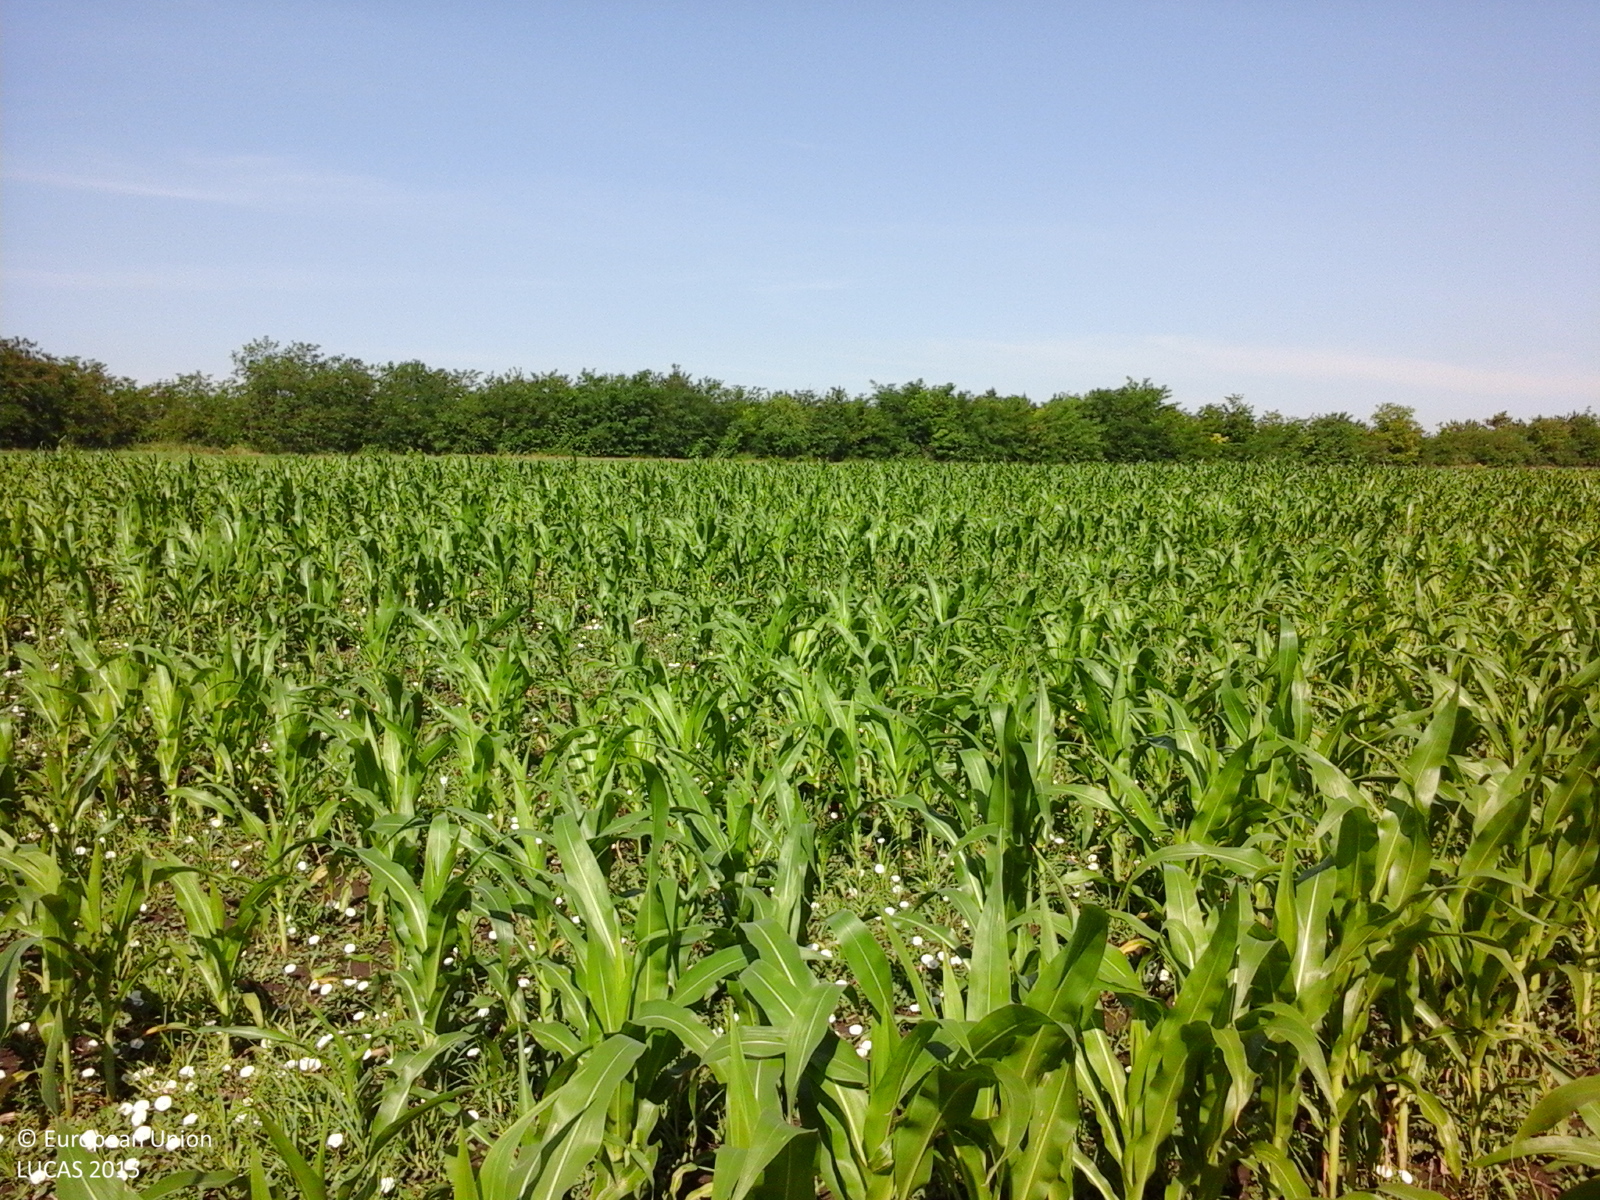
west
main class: Cropland
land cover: Maize
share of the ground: 50 - 75 %
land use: Agriculture (excluding fallow land and kitchen gardens)
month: June
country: RO
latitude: 47.5641
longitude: 27.2708
